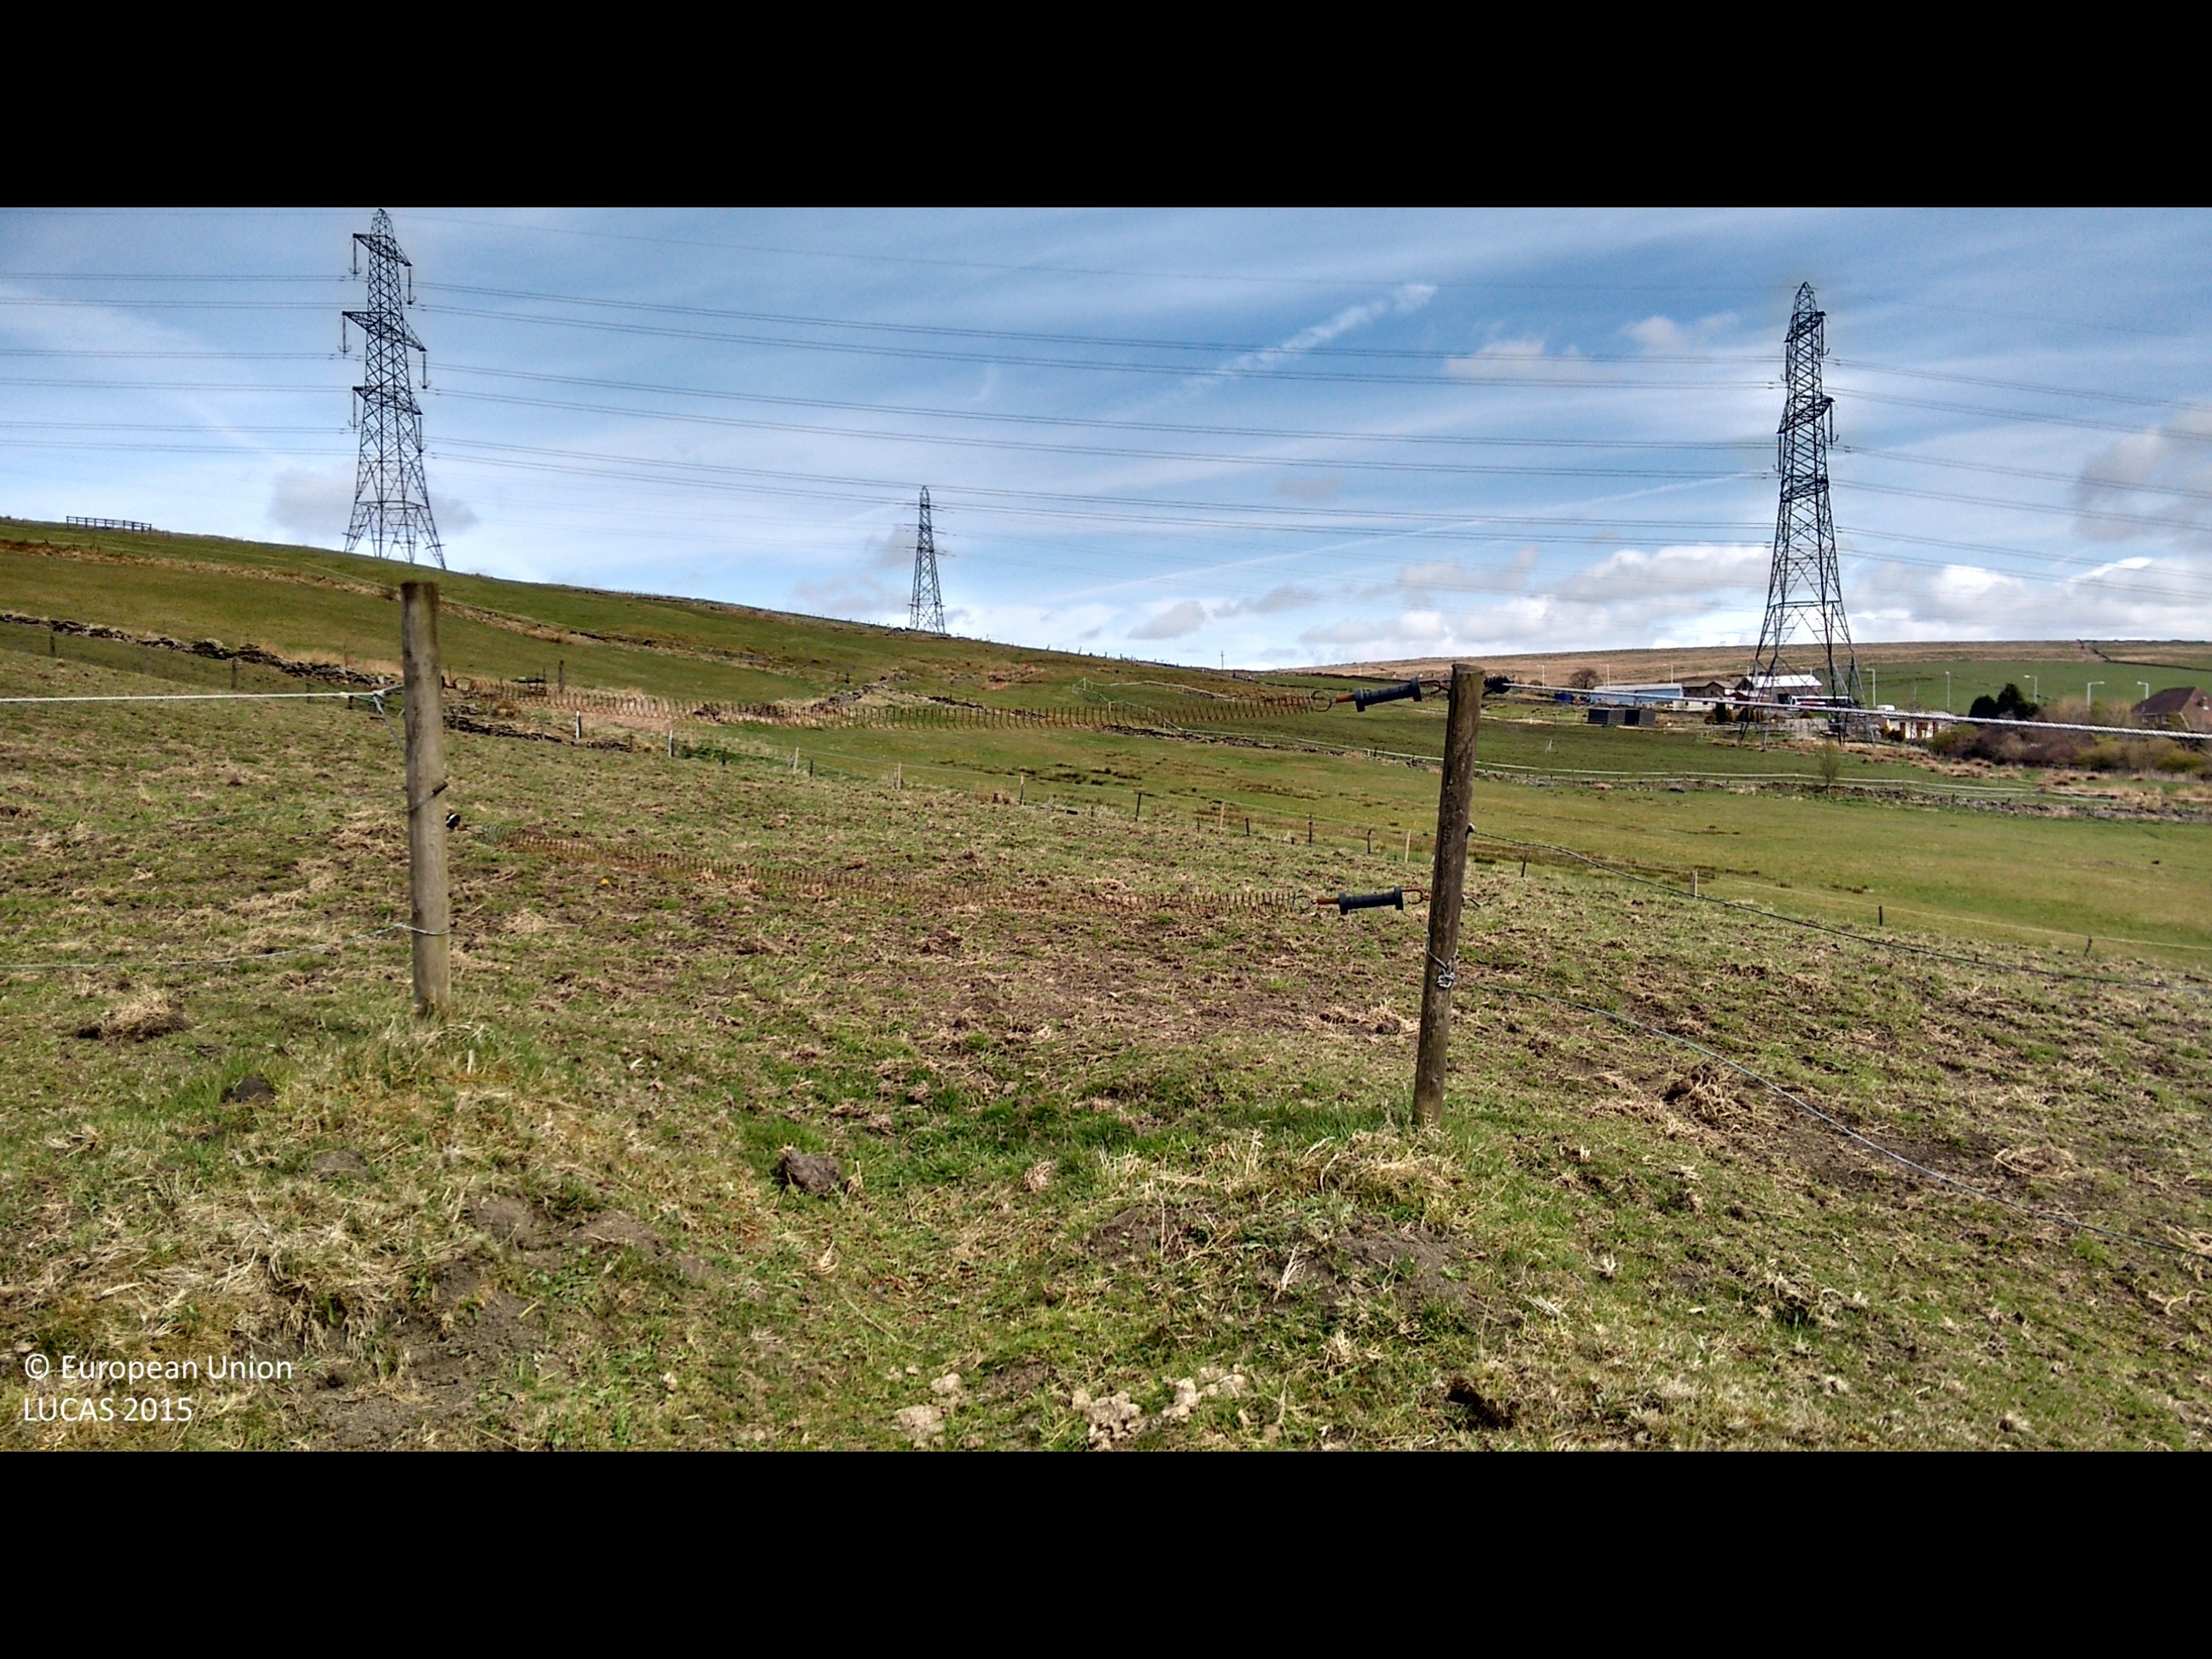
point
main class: Grassland
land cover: Grassland without tree/shrub cover
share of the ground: > 75 %
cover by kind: herbaceous plants 100 %
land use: Agriculture (excluding fallow land and kitchen gardens)
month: May
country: GB
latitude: 53.7282
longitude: -2.2011
